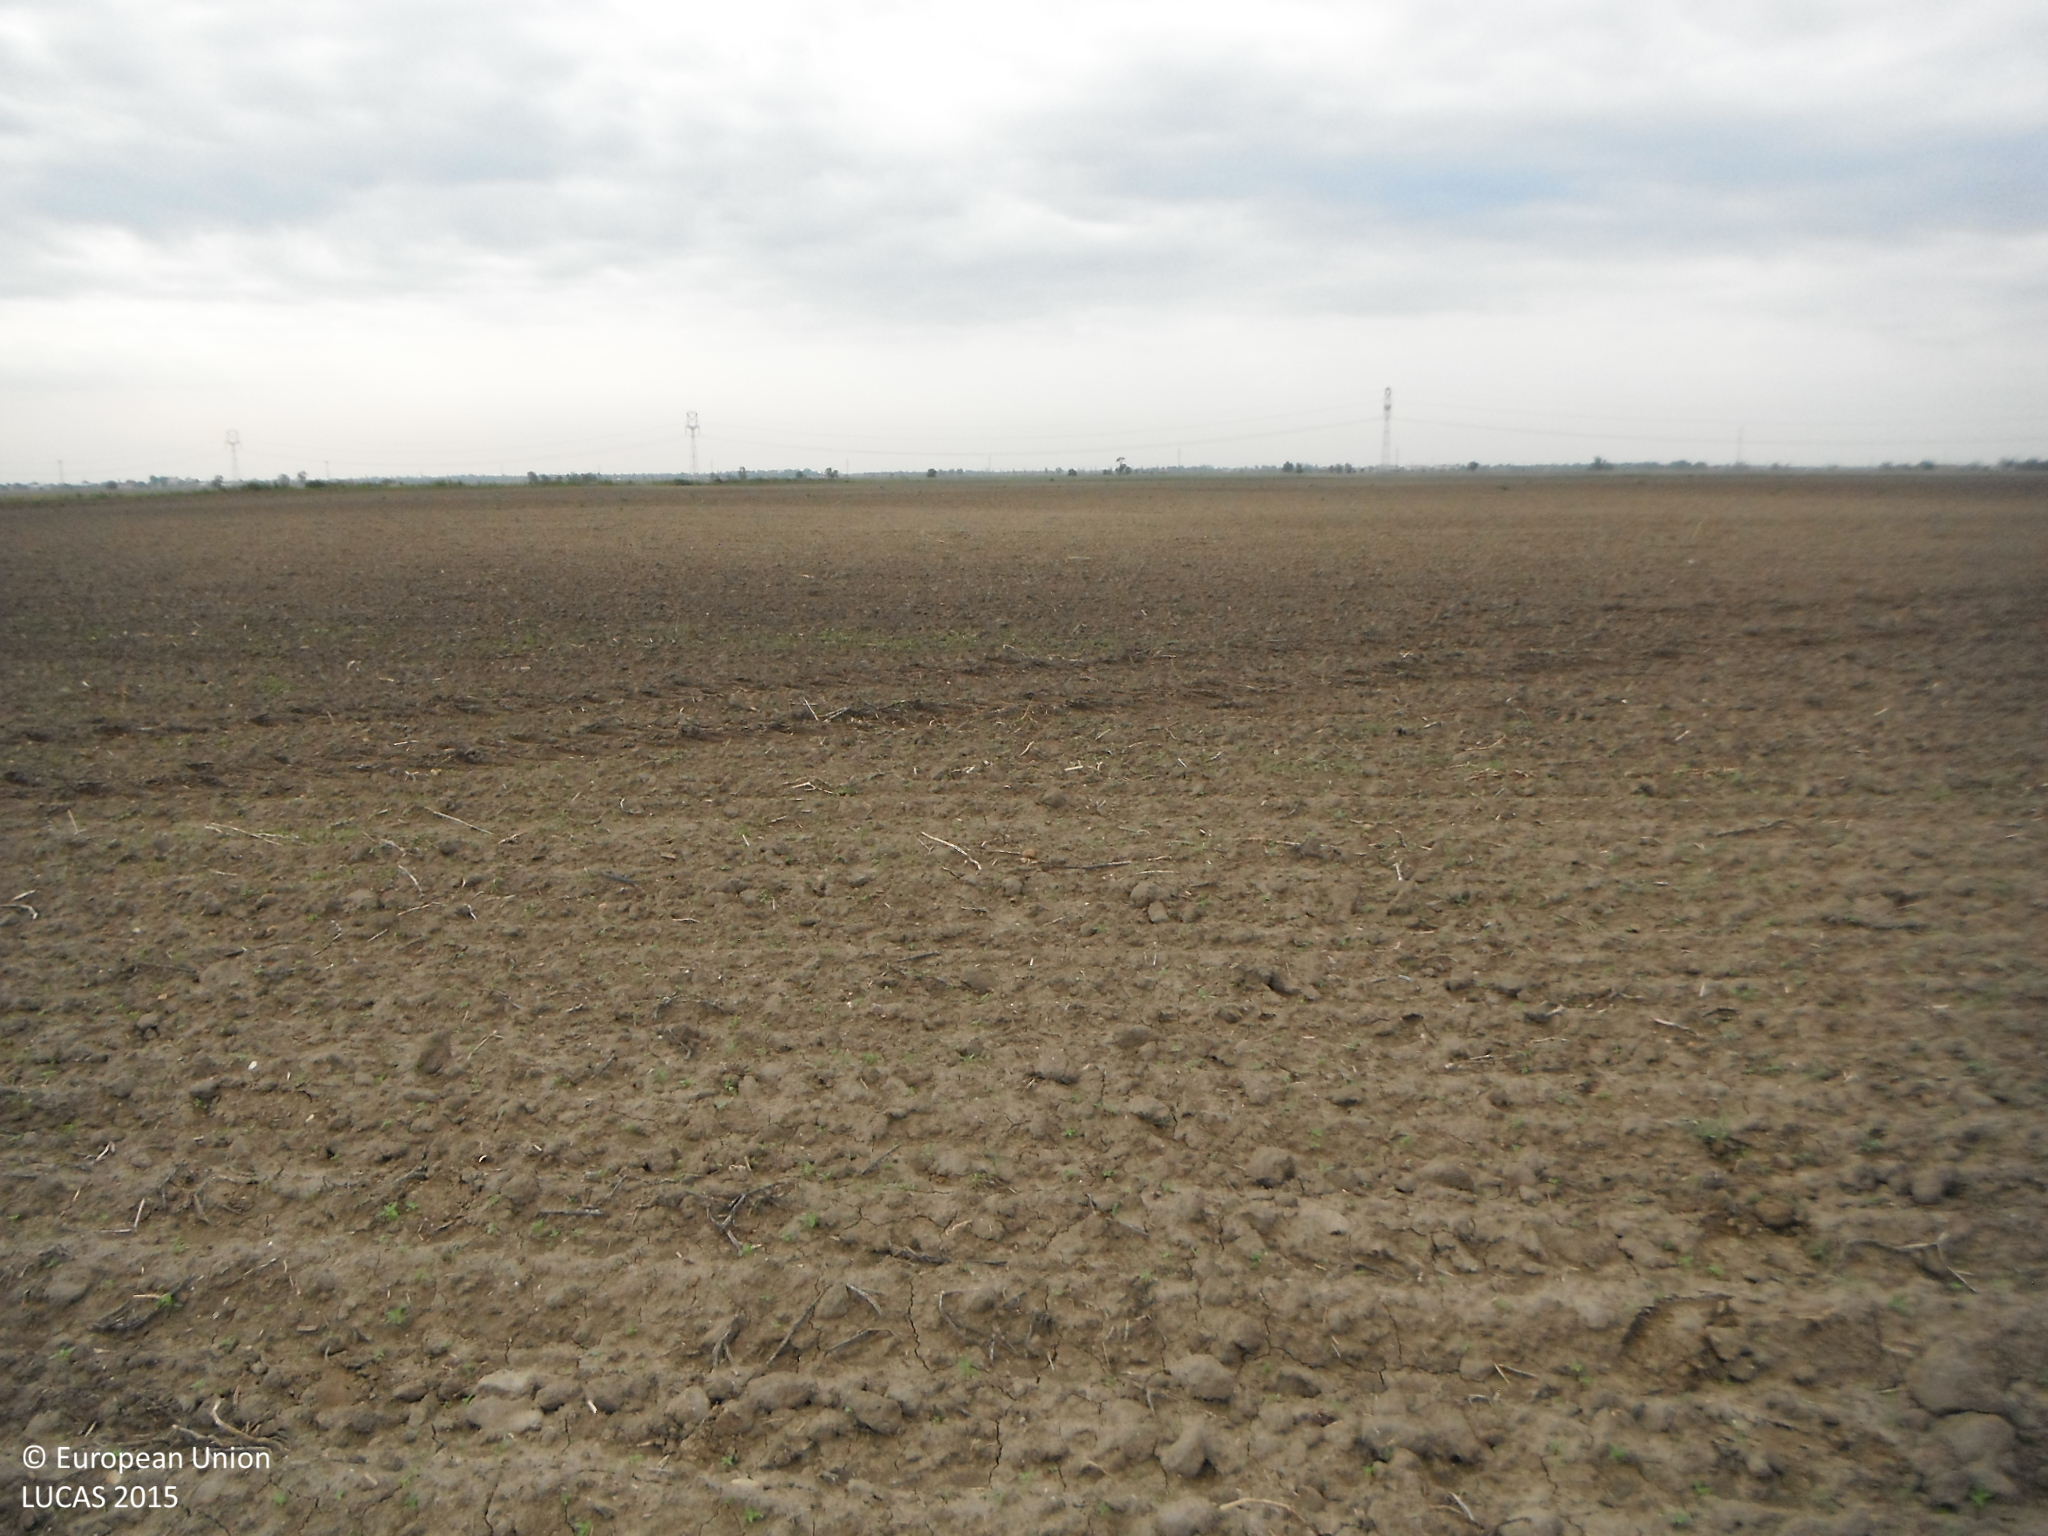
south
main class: Cropland
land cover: Potatoes
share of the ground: < 10 %
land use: Agriculture (excluding fallow land and kitchen gardens)
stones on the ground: < 10 %
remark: Harvested field
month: September
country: SK
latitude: 48.1239
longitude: 17.3308
